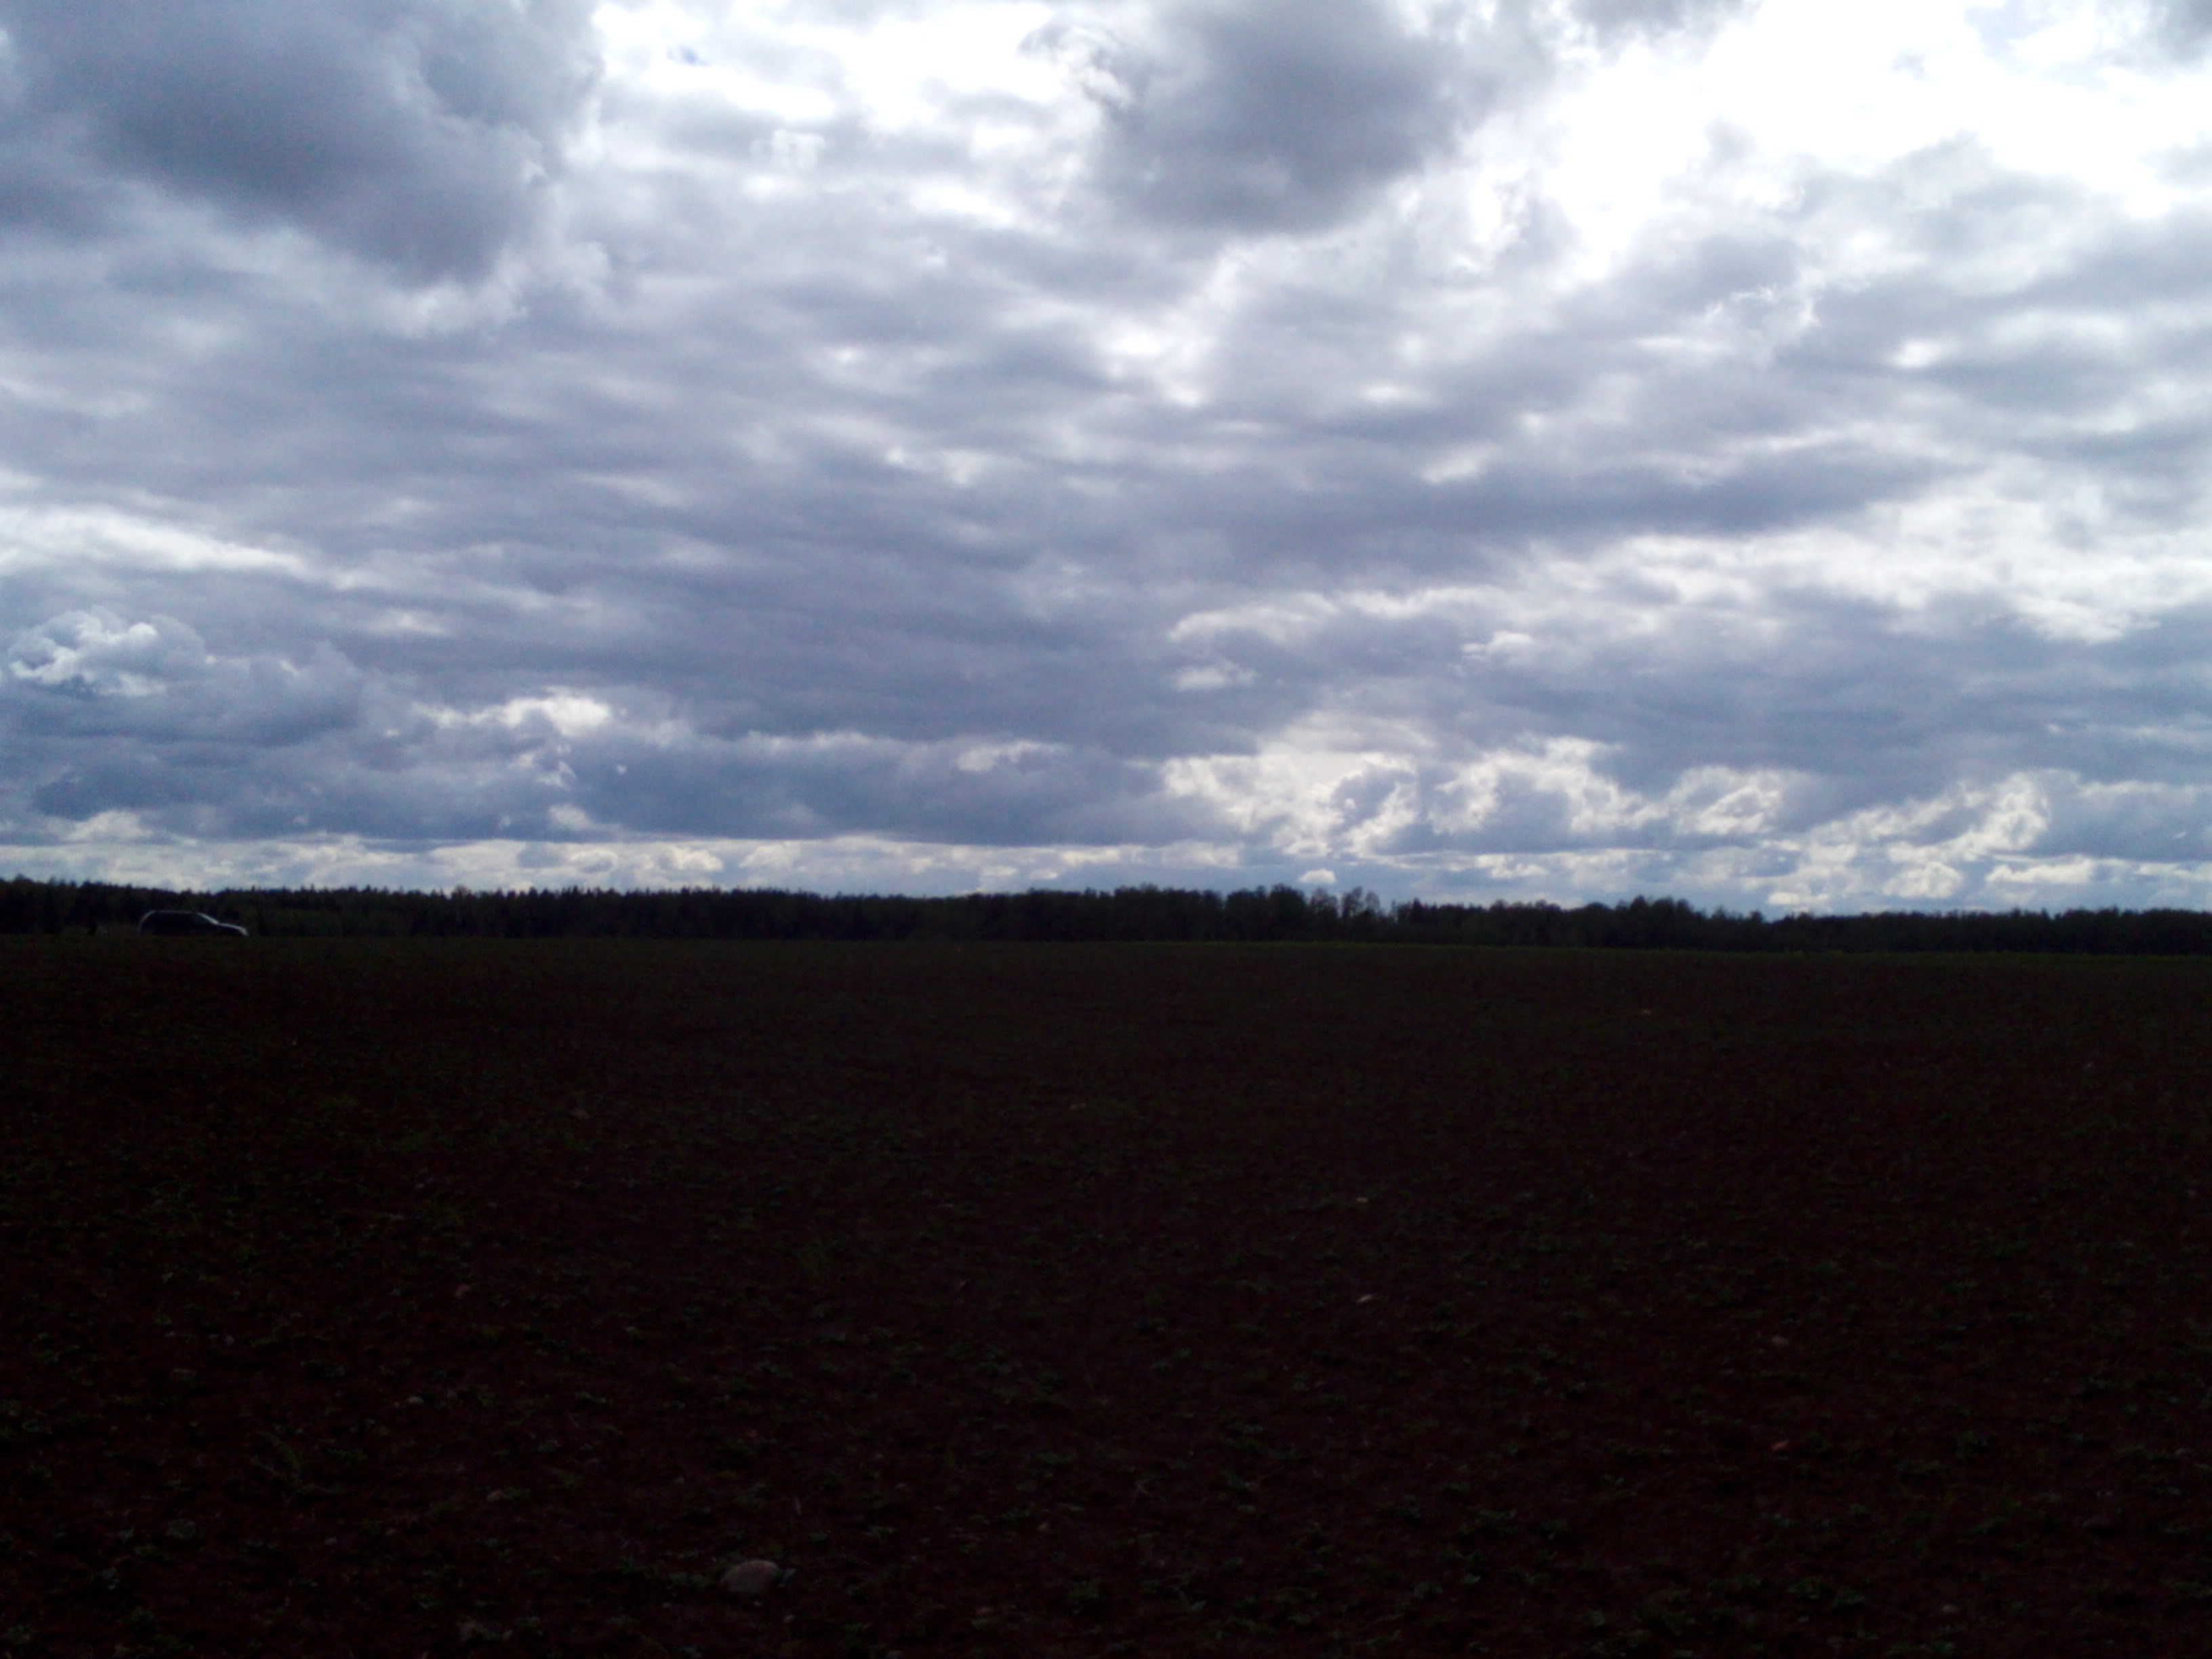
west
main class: Cropland
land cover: Dry pulses
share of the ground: 10 - 25 %
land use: Agriculture (excluding fallow land and kitchen gardens)
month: May
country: LV
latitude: 56.7581
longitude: 22.8697
